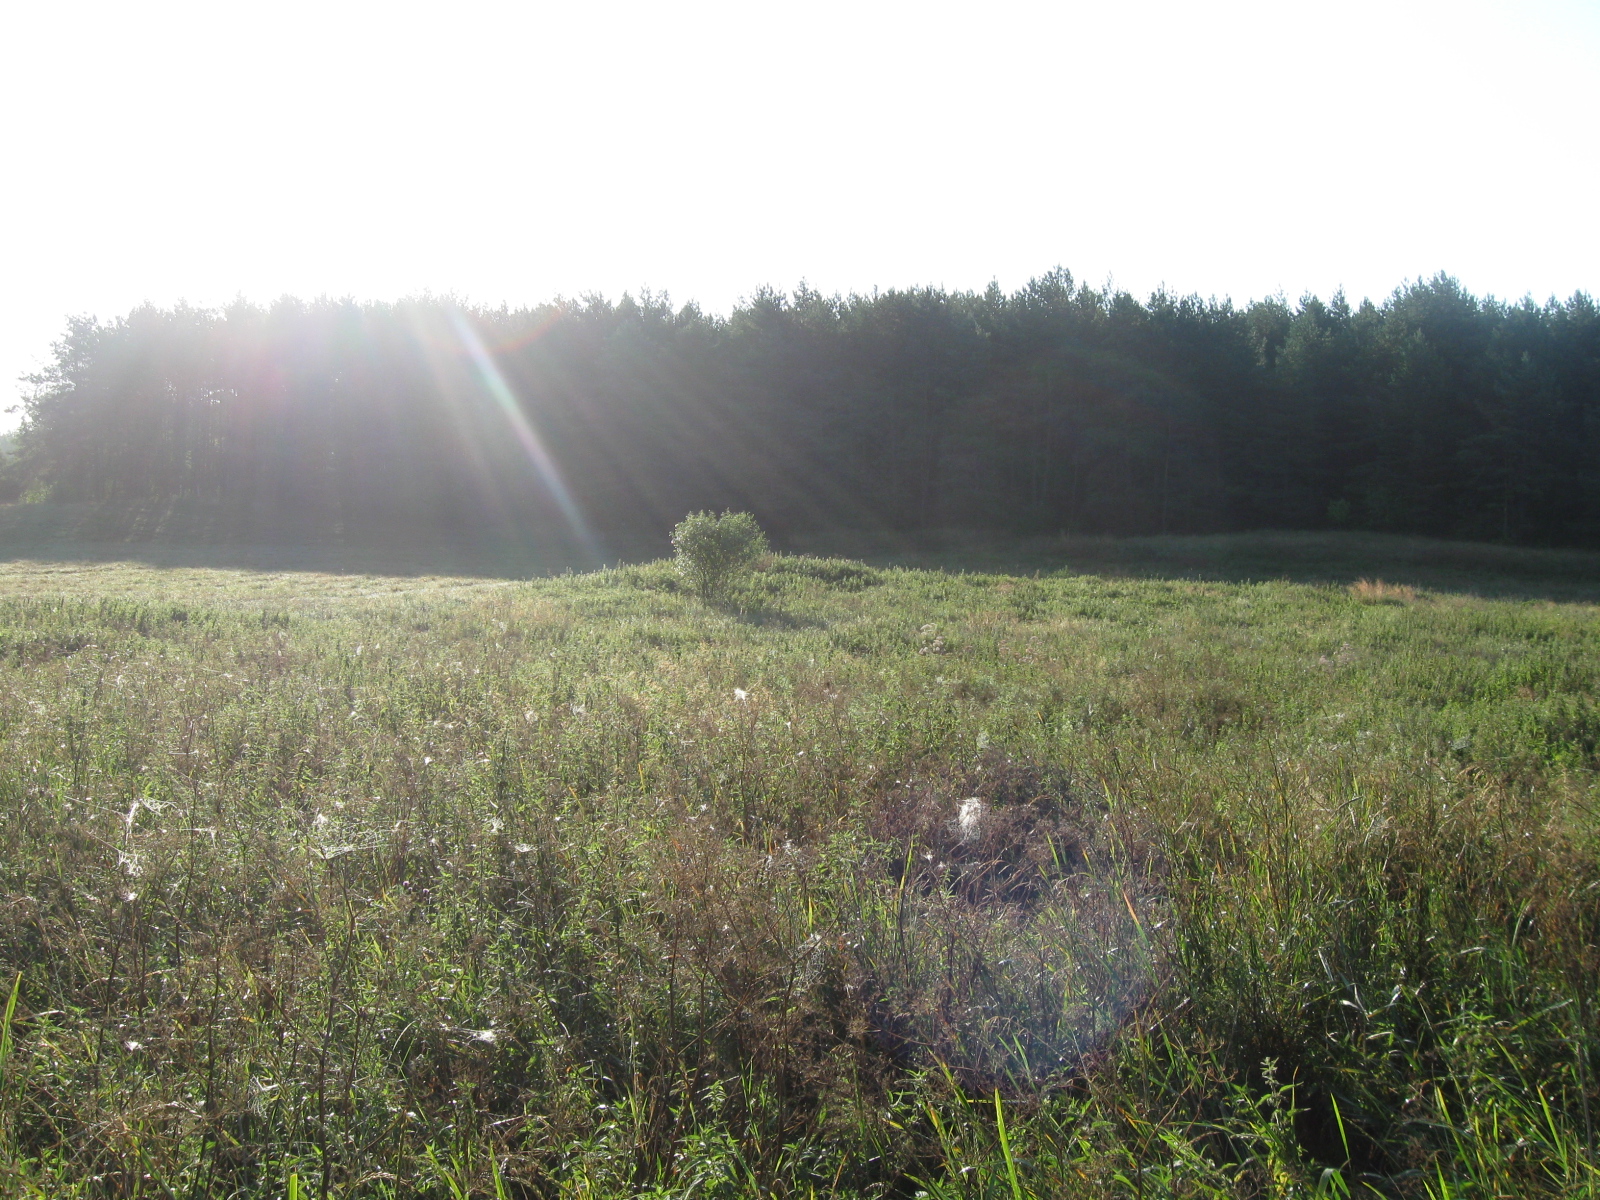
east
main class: Grassland
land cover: Grassland without tree/shrub cover
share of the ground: > 75 %
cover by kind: herbaceous plants 100 %
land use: Agriculture (excluding fallow land and kitchen gardens)
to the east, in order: Grassland without tree/shrub cover; Pine dominated coniferous woodland; Tracks; Pine dominated coniferous woodland; Other mixed woodland; Broadleaved woodland
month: July
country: LT
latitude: 54.1382
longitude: 23.8189
